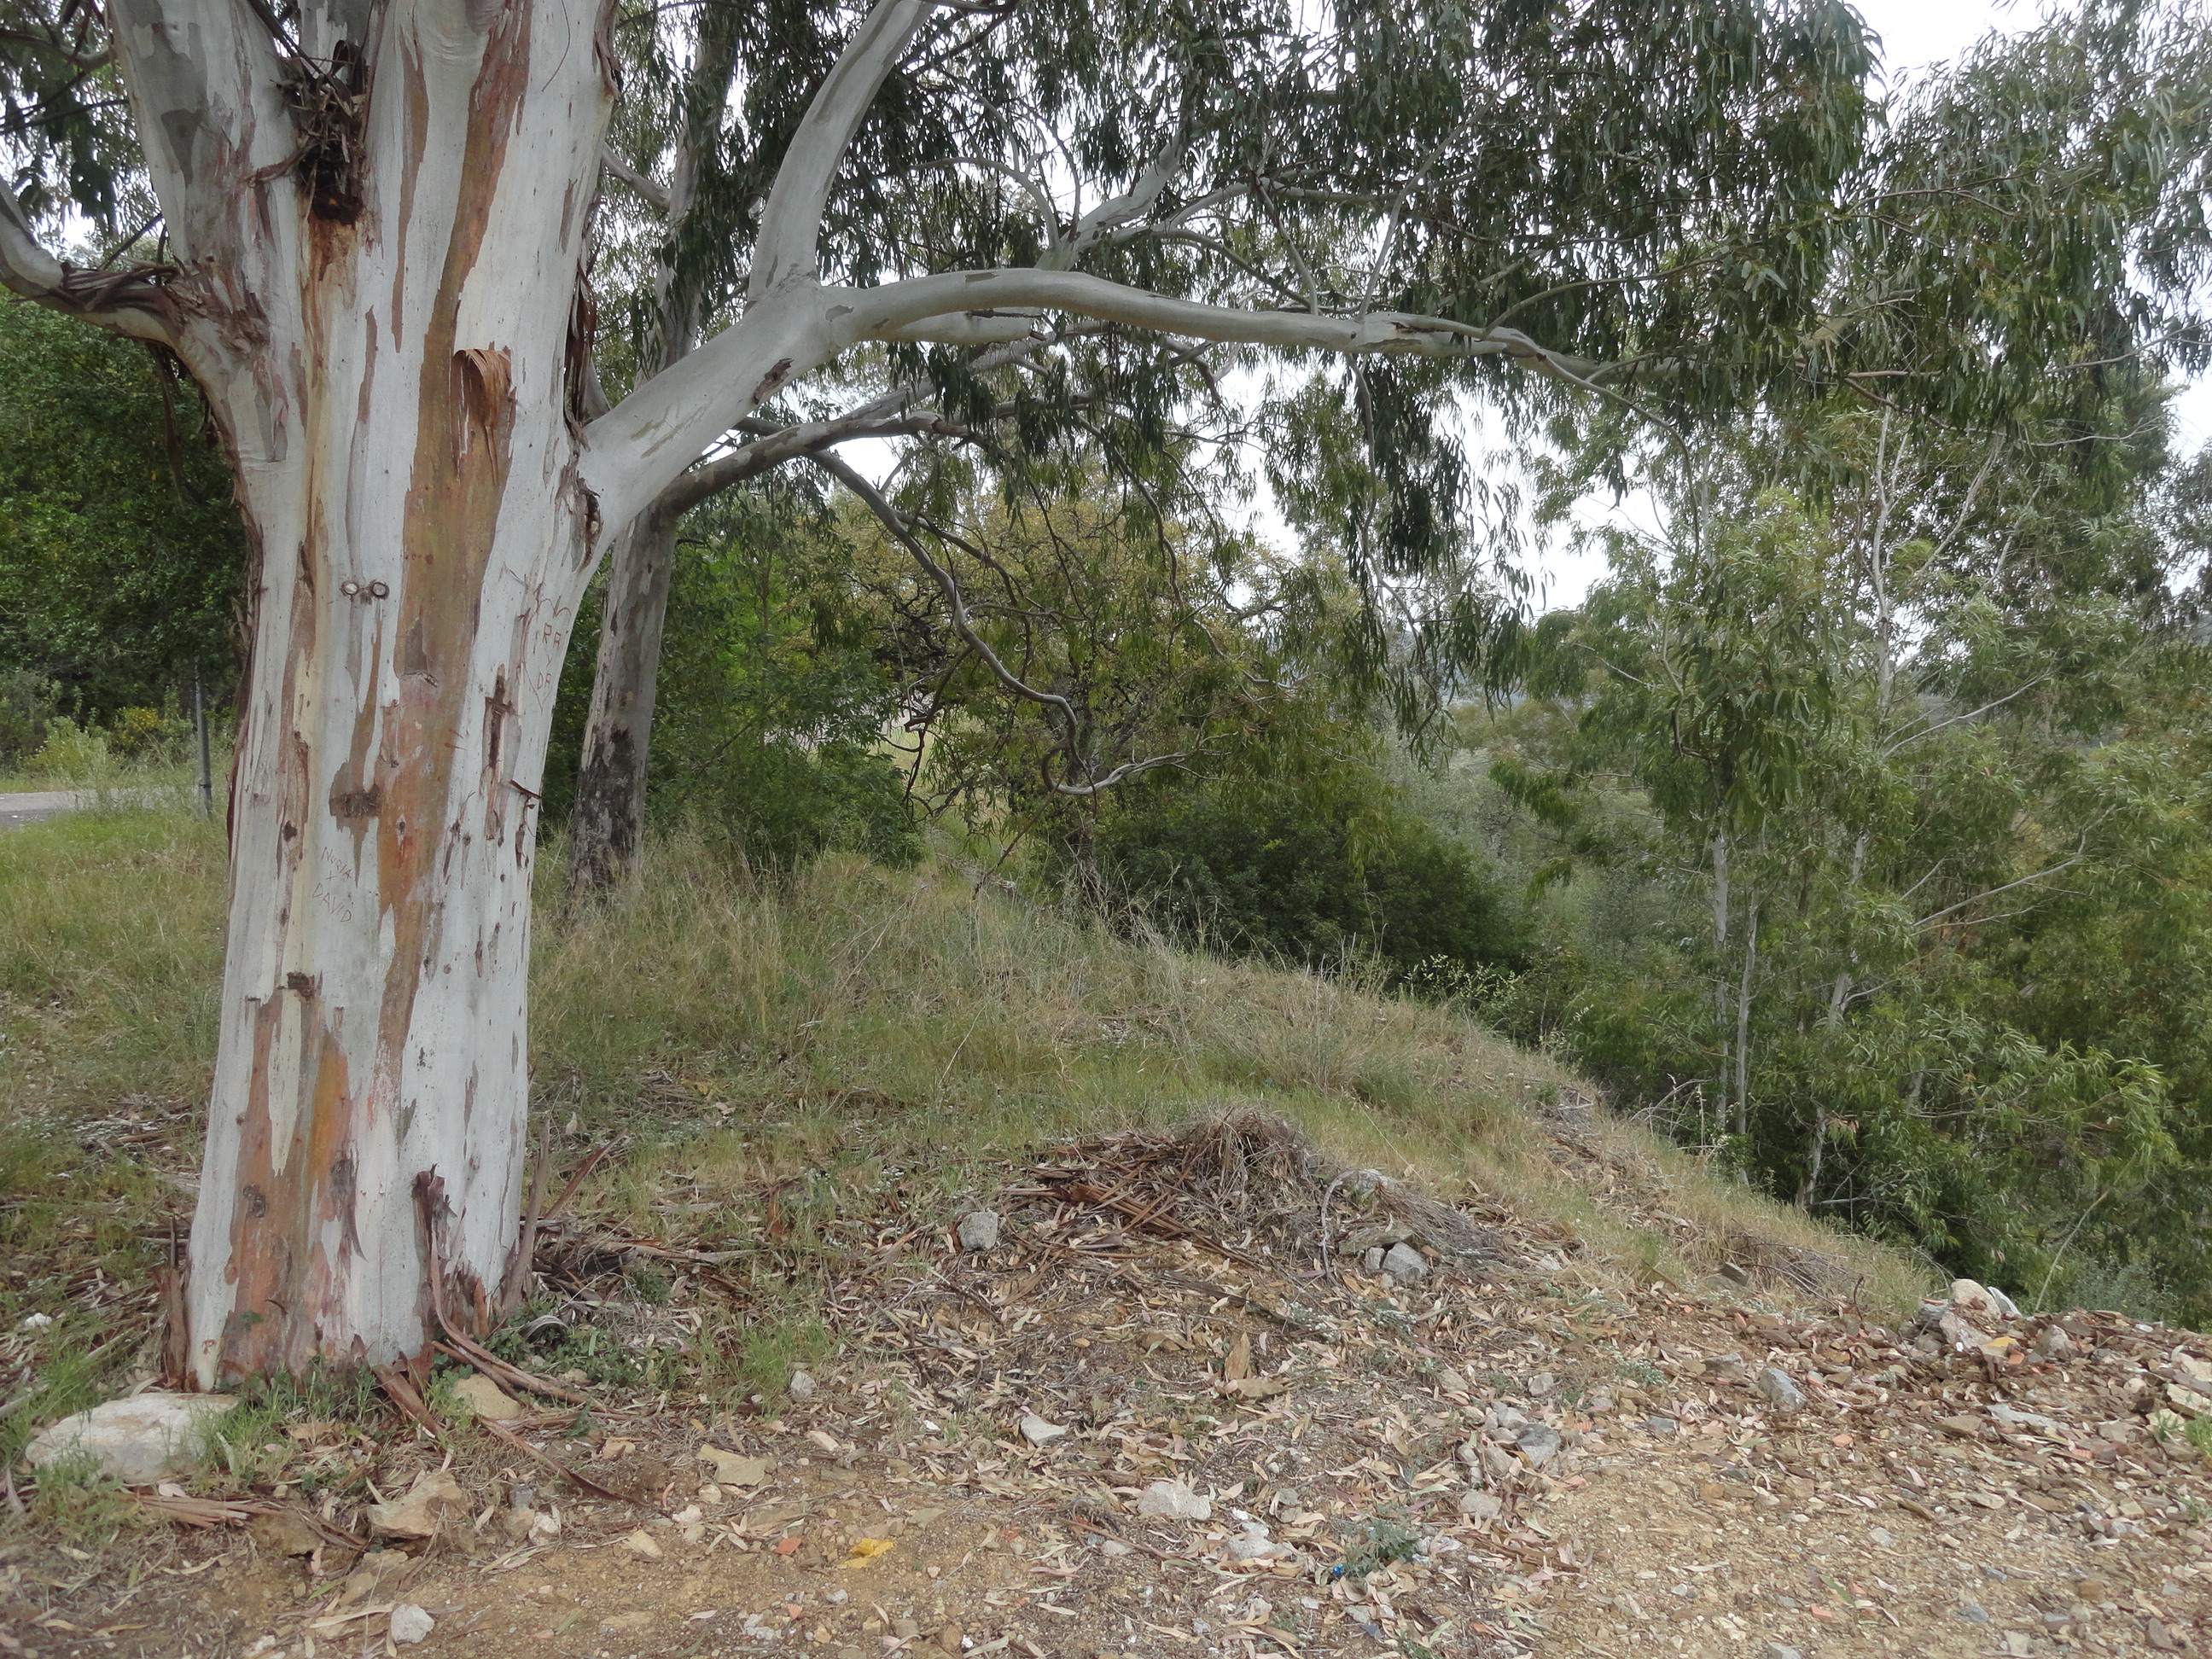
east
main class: Woodland
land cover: Broadleaved woodland
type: broadleaved evergreen forest
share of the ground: > 75 %
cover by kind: broadleaved forest trees 85 %, shrubs 5 %, herbaceous plants 5 %, unconsolidated bare surface 5 %
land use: Semi-natural and natural areas not in use
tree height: > 5 m
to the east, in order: Broadleaved woodland
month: April
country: ES
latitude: 37.8981
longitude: -5.2025
